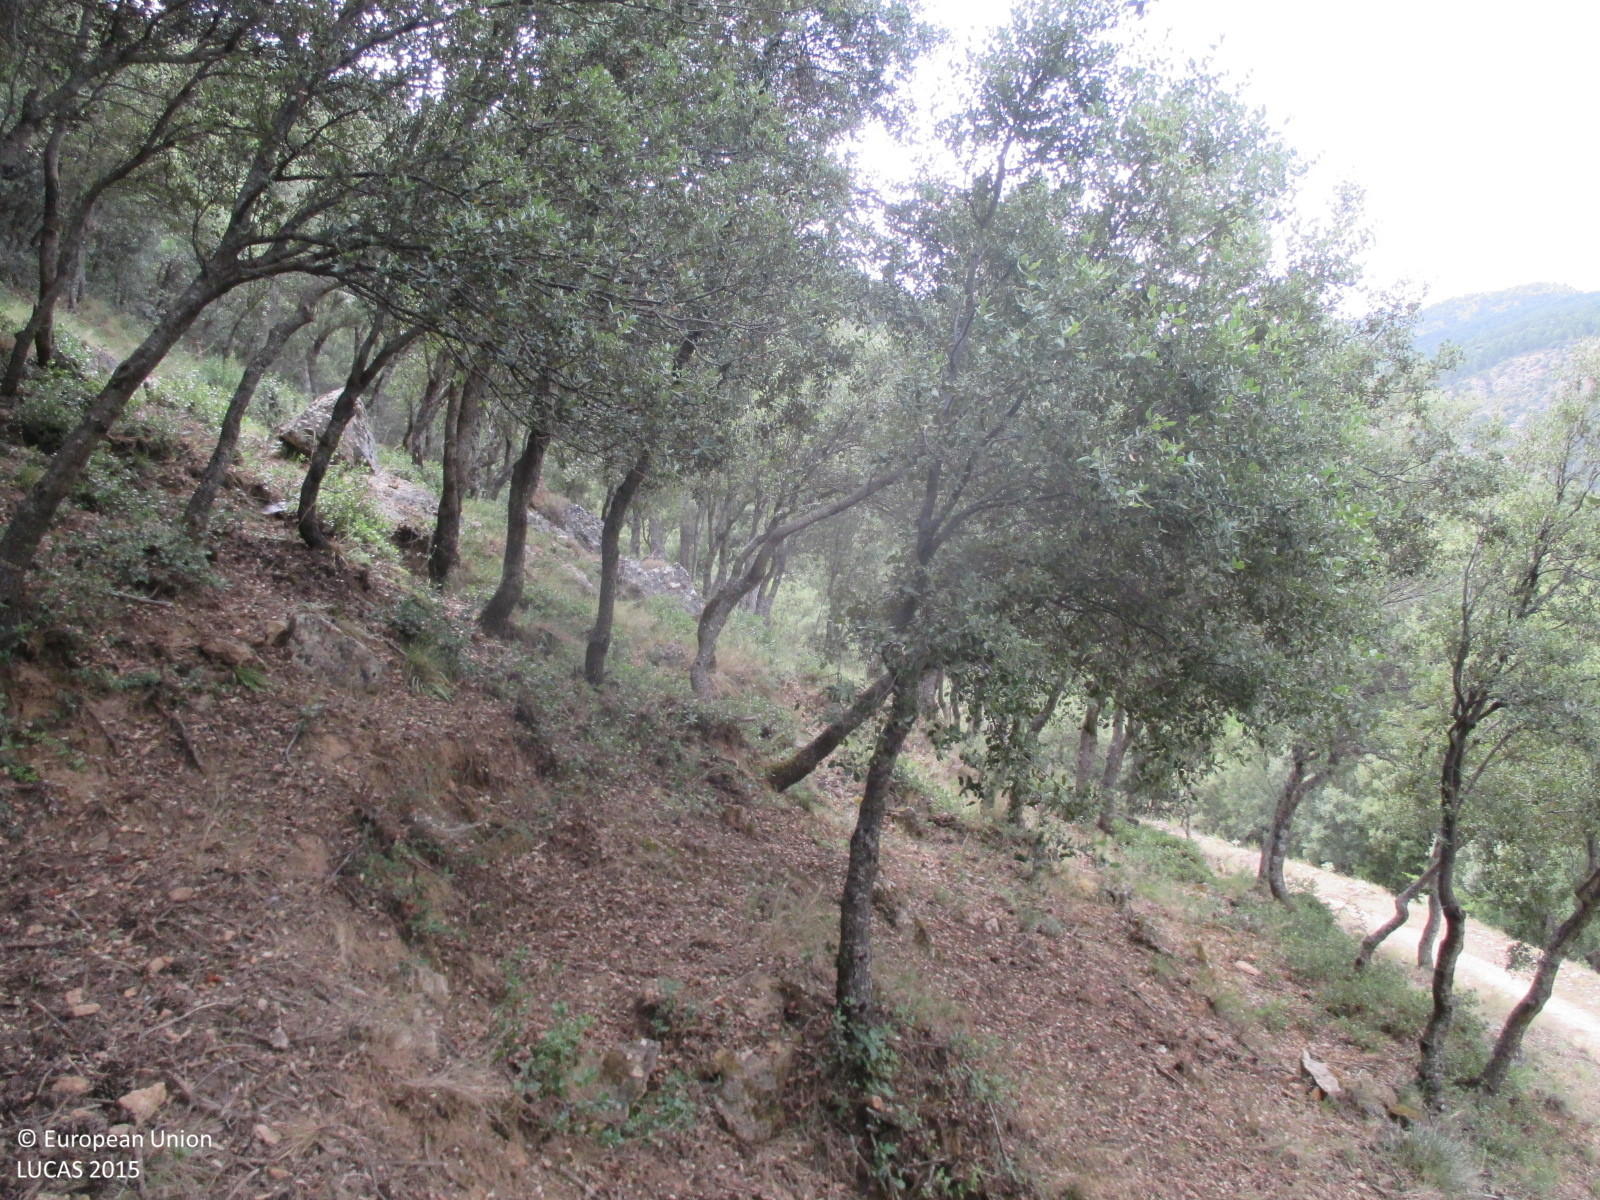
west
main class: Woodland
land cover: Broadleaved woodland
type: broadleaved evergreen forest
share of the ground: > 75 %
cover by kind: broadleaved forest trees 95 %, coniferous forest trees 5 %
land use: Forestry
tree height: > 5 m
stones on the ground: < 10 %
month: July
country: ES
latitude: 38.1870
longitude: -2.4735
